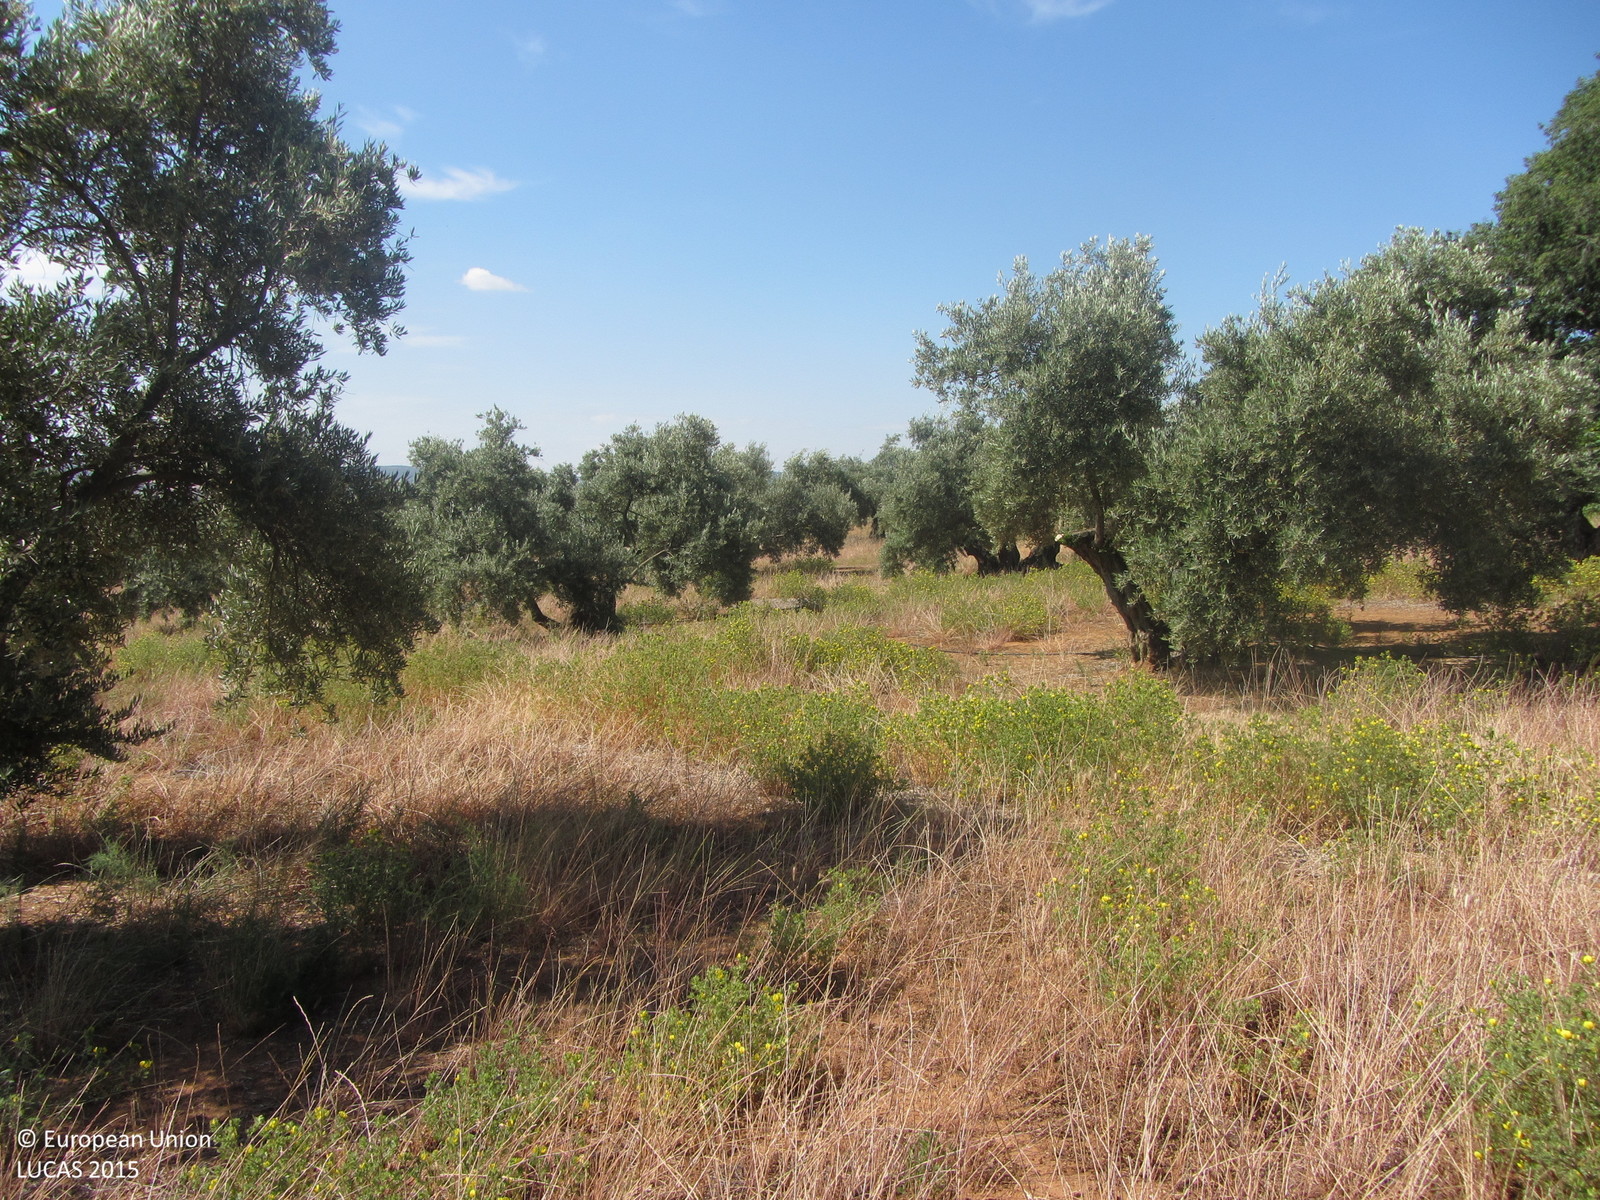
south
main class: Cropland
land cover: Olive groves
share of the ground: 25 - 50 %
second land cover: Spontaneously vegetated surfaces
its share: > 75 %
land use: Agriculture (excluding fallow land and kitchen gardens)
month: May
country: ES
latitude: 38.1519
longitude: -3.2728
